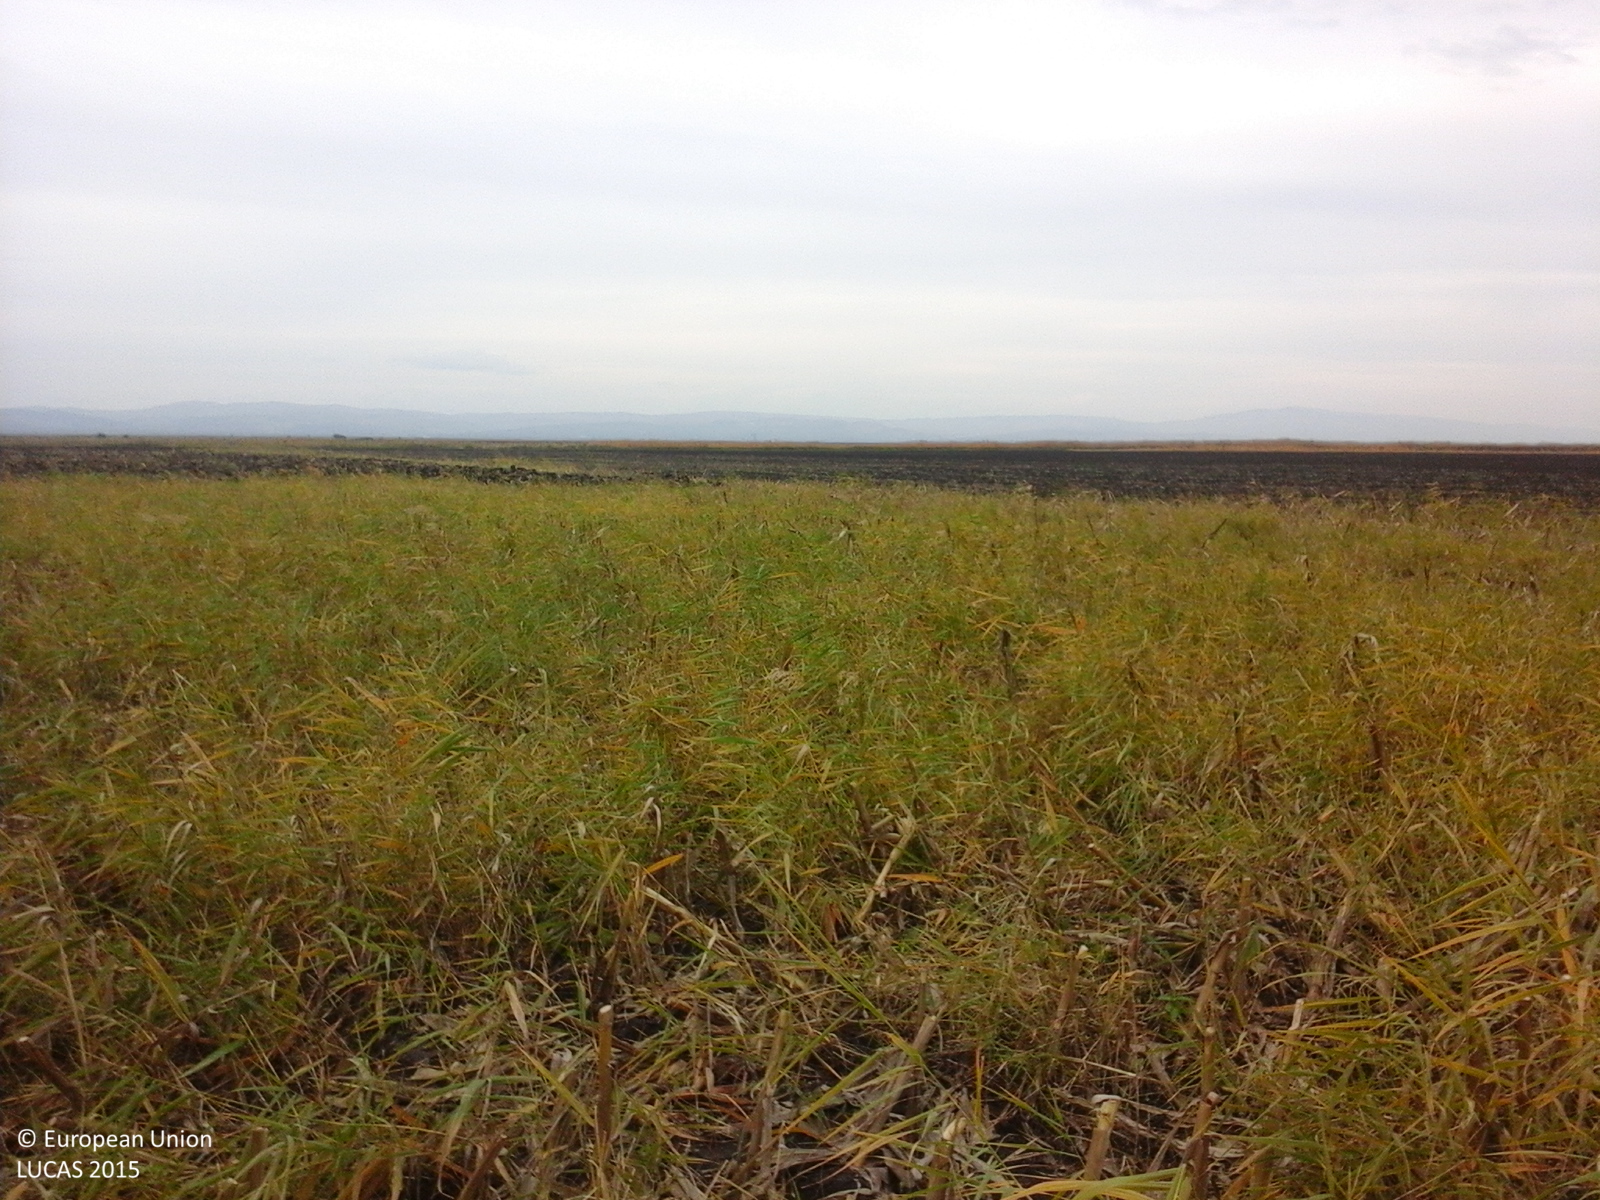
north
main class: Cropland
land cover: Maize
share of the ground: 50 - 75 %
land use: Agriculture (excluding fallow land and kitchen gardens)
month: October
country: RO
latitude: 44.9277
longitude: 26.3983
